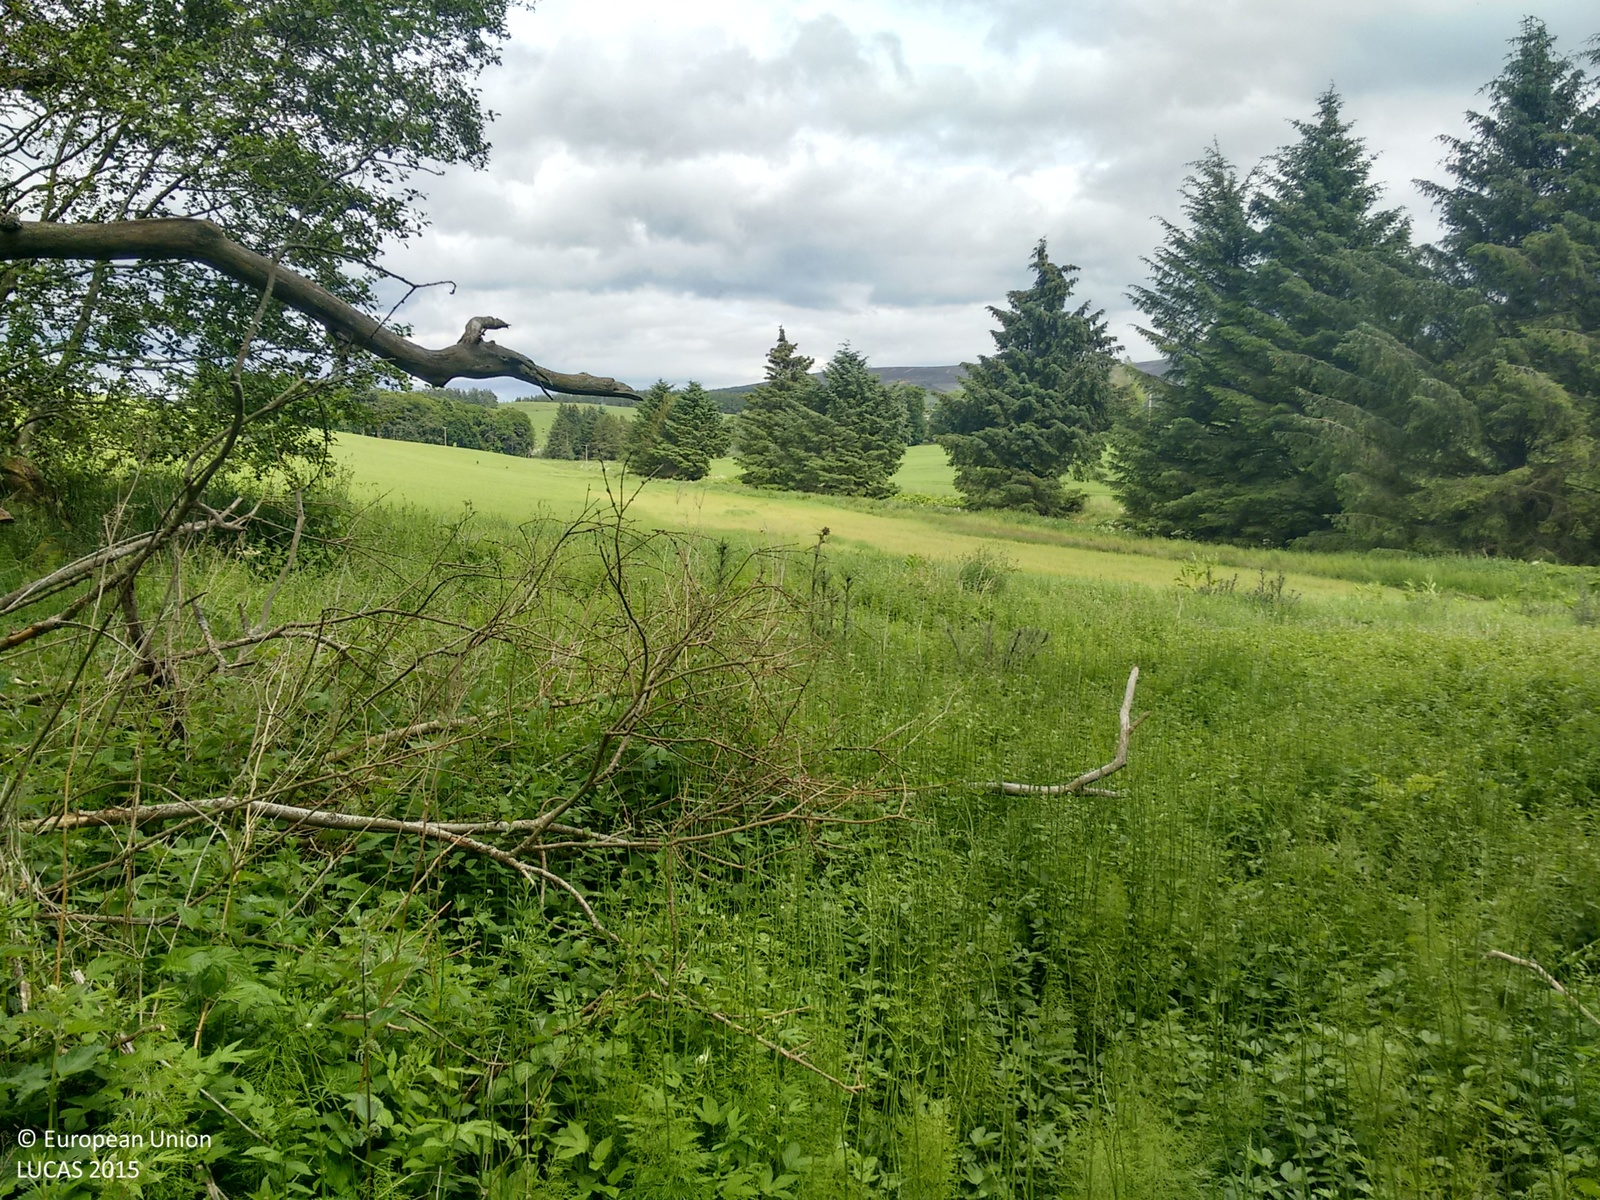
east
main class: Woodland
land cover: Broadleaved woodland
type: exotic forest
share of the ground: > 75 %
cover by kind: broadleaved forest trees 75 %, herbaceous plants 25 %
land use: Semi-natural and natural areas not in use
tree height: > 5 m
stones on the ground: < 10 %
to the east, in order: Broadleaved woodland; Dry stone walls; Fences; Grass margins; Ditches and canals; Spontaneously vegetated surfaces; Barley; Grass margins; Fences; Spontaneously vegetated surfaces; Inland fresh running water; Spontaneously vegetated surfaces; Barley
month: June
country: GB
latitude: 57.1750
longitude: -2.7112
